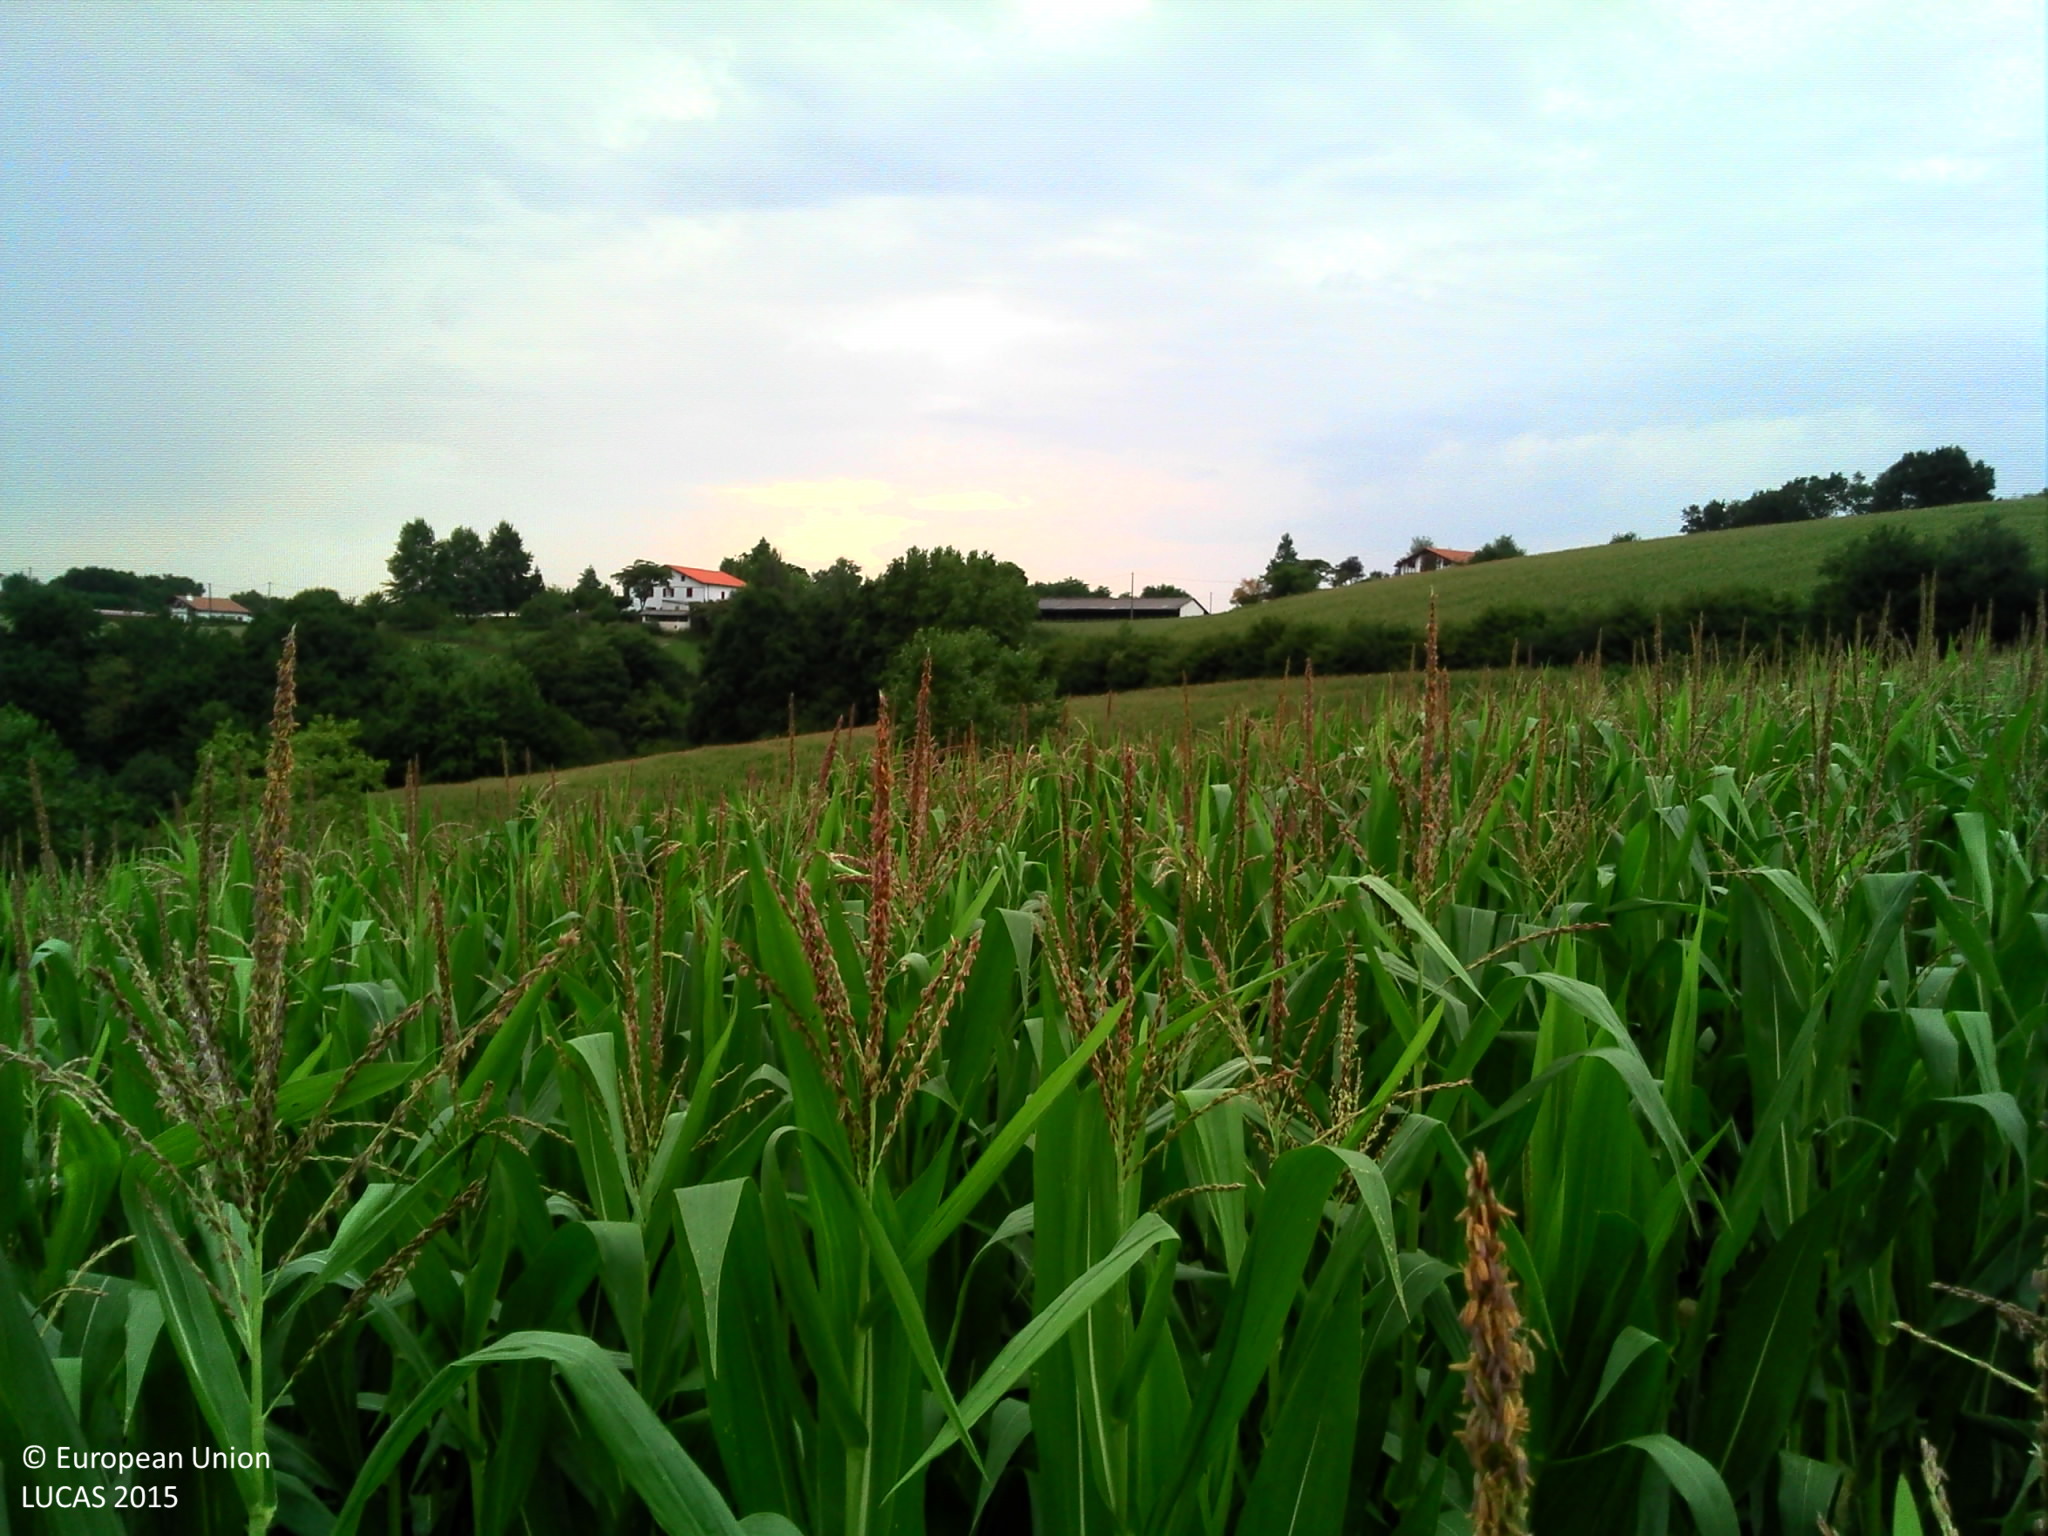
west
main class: Cropland
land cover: Maize
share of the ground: > 75 %
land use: Agriculture (excluding fallow land and kitchen gardens)
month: August
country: FR
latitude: 43.4253
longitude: -1.2686
